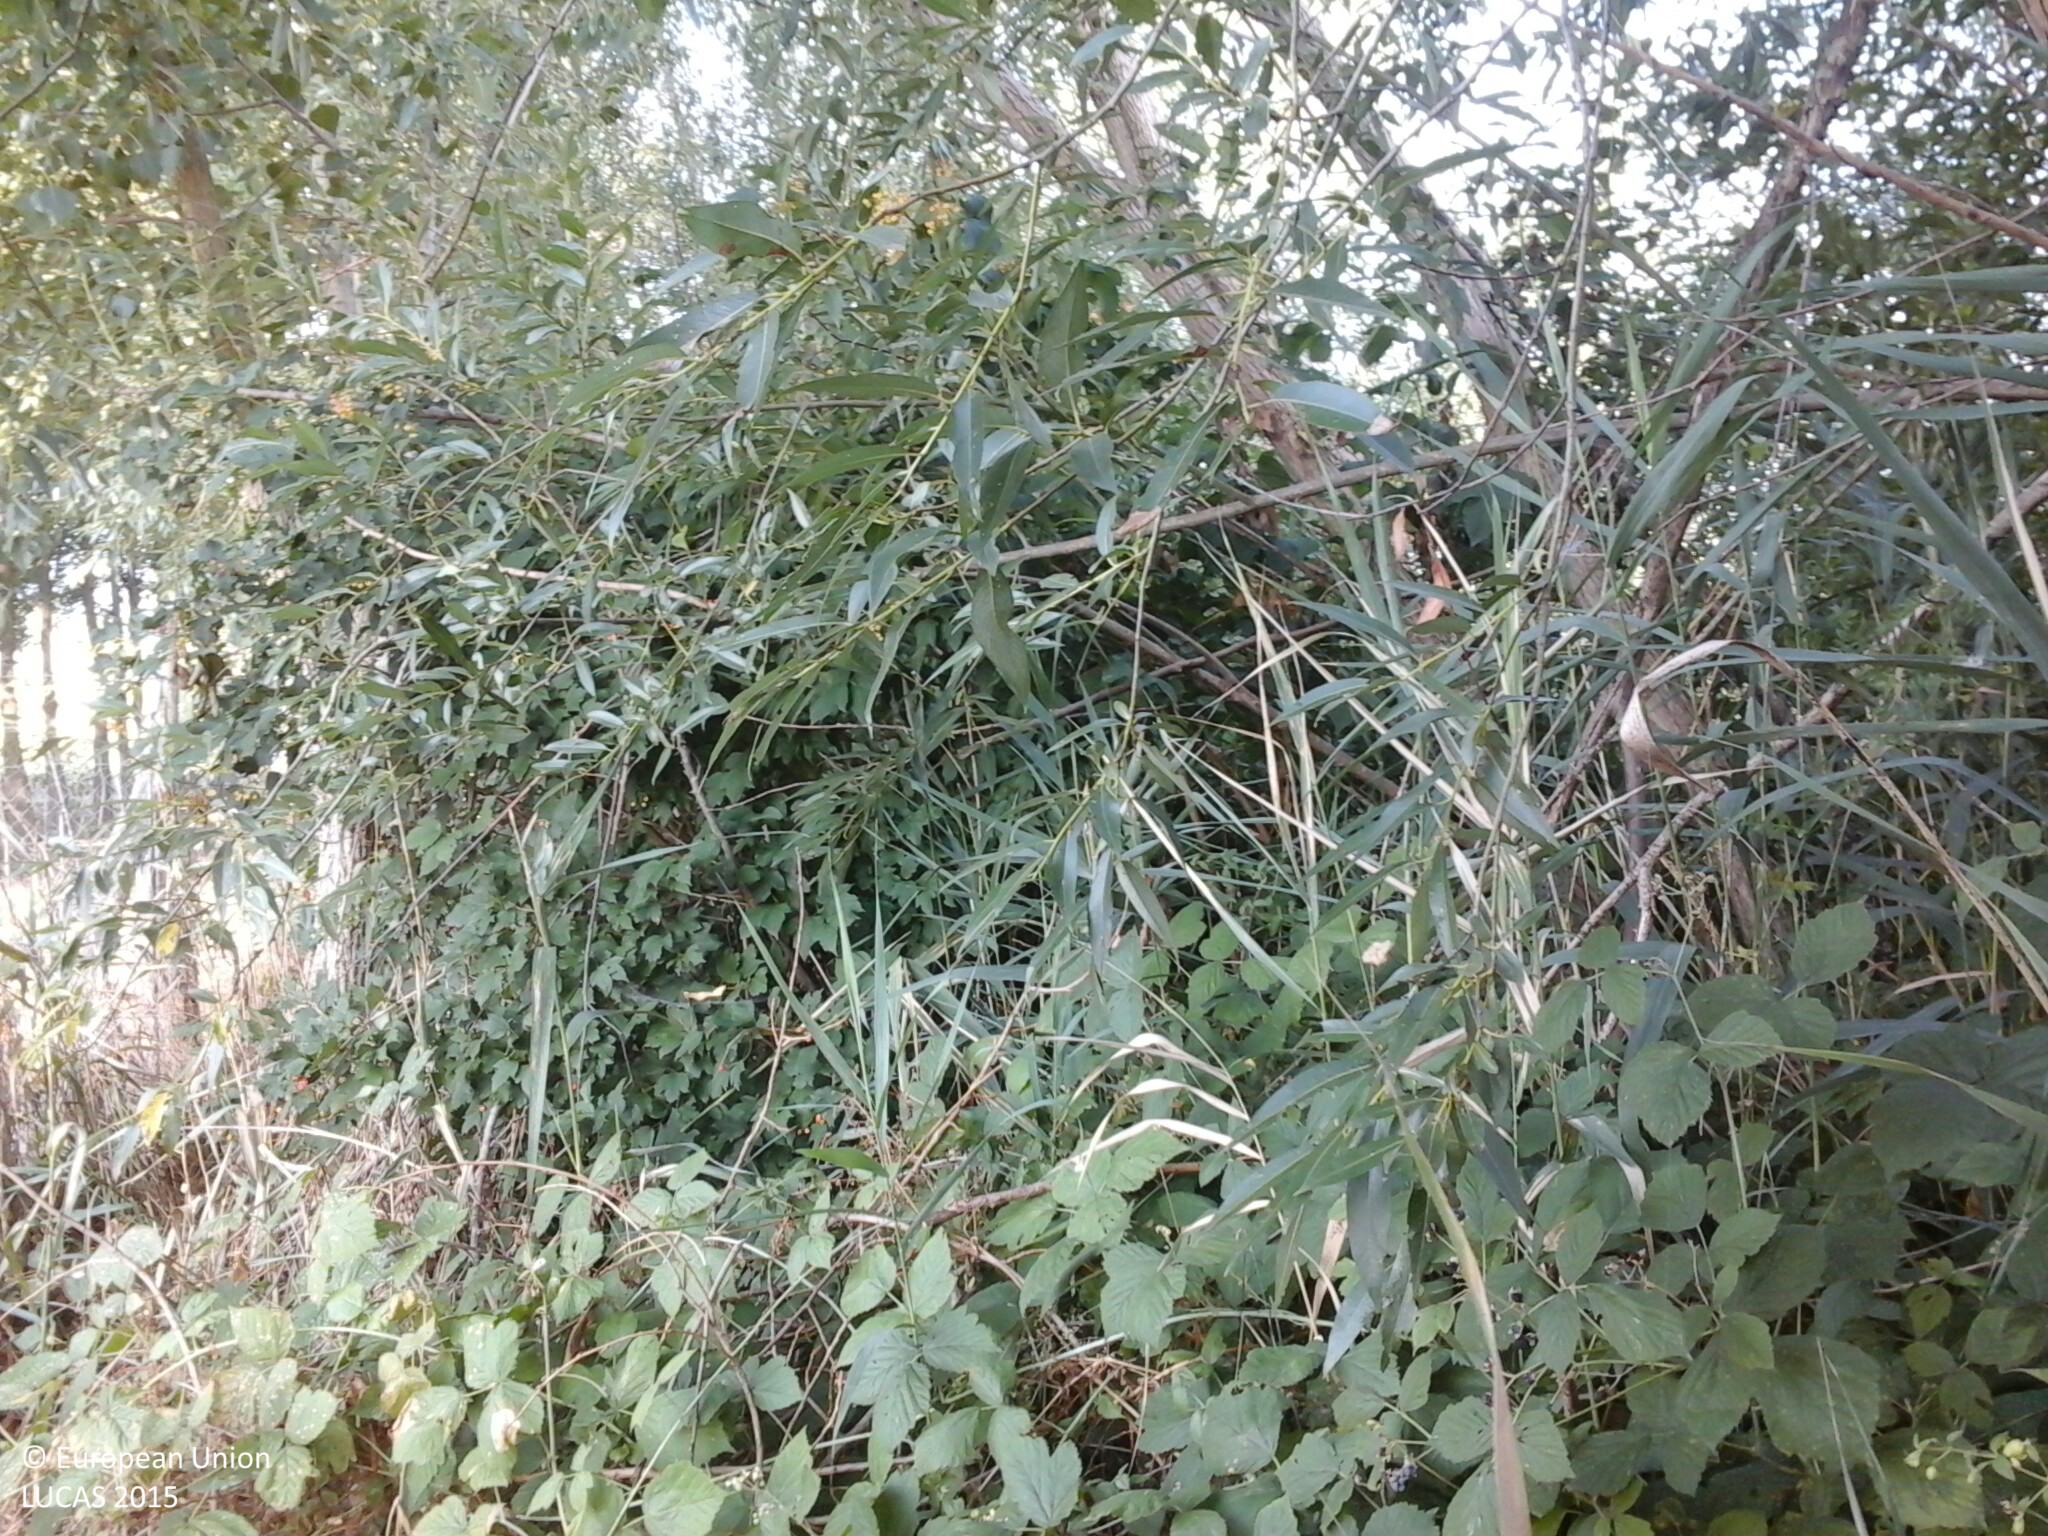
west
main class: Woodland
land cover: Broadleaved woodland
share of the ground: > 75 %
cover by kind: broadleaved forest trees 95 %, herbaceous plants 5 %
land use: Forestry
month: July
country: HU
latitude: 47.9729
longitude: 21.9328
